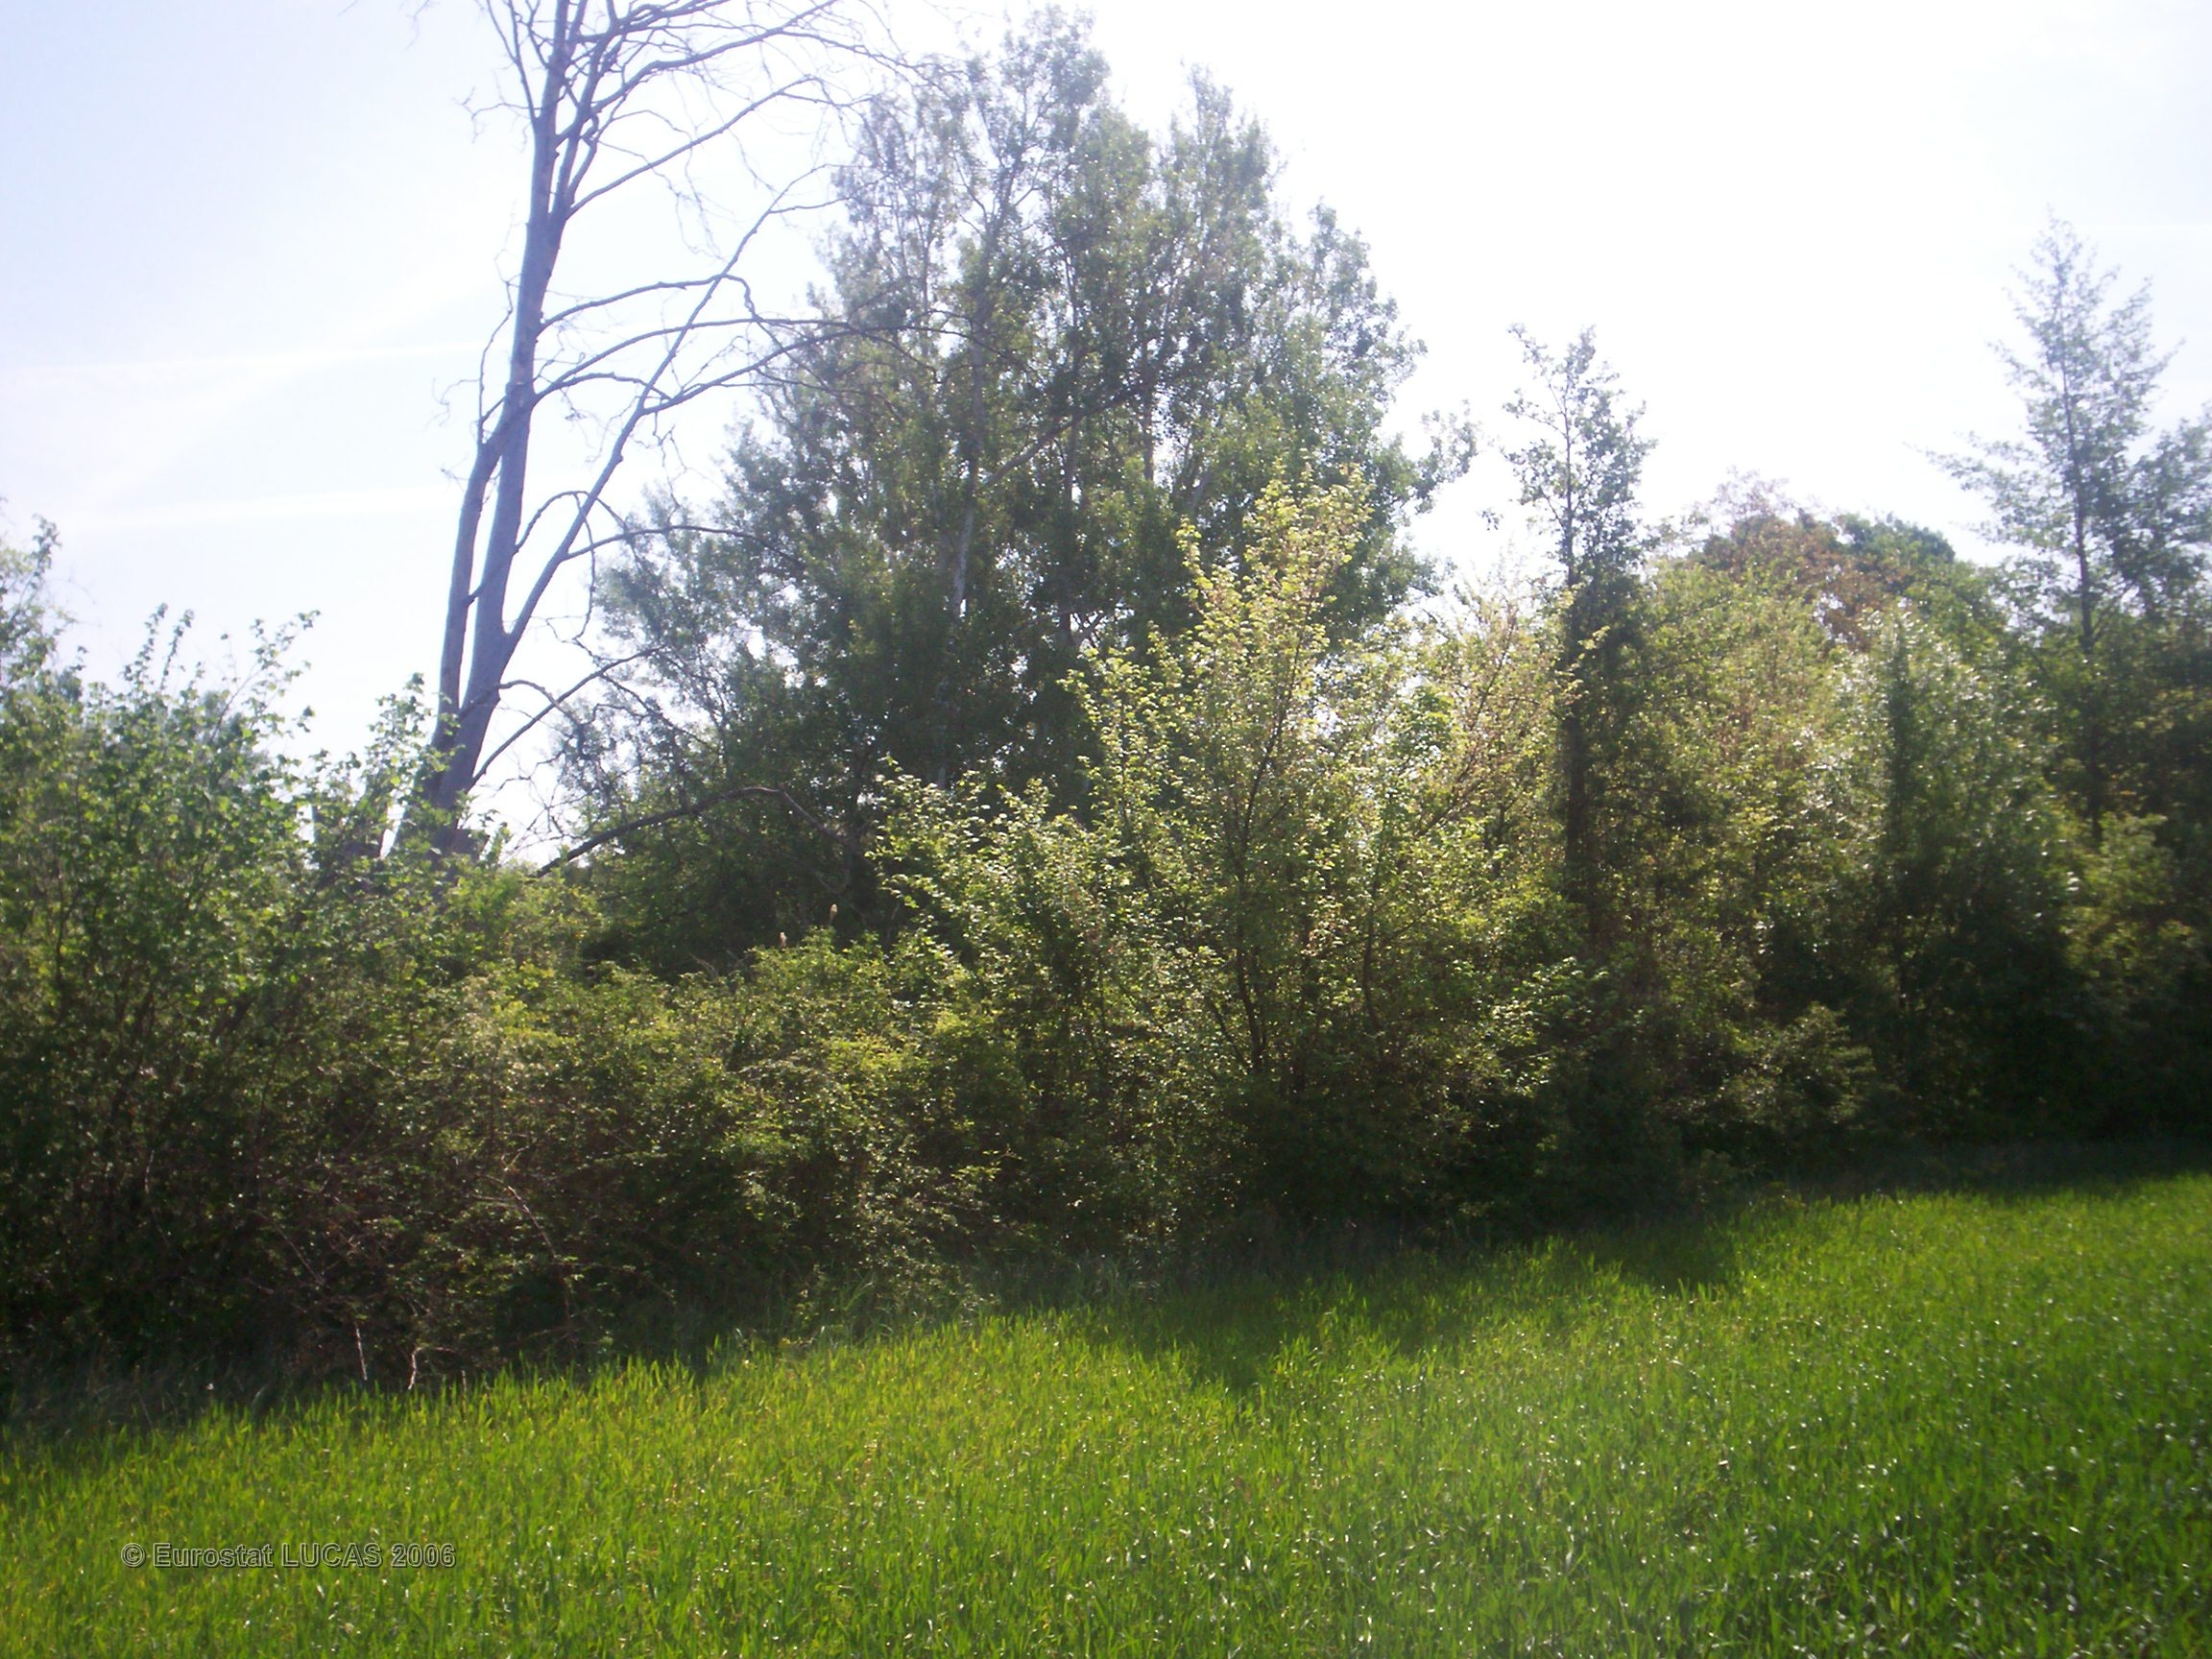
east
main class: Cropland
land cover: Durum wheat
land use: Agriculture (excluding fallow land and kitchen gardens)
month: April
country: FR
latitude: 43.9763
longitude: 4.9847
